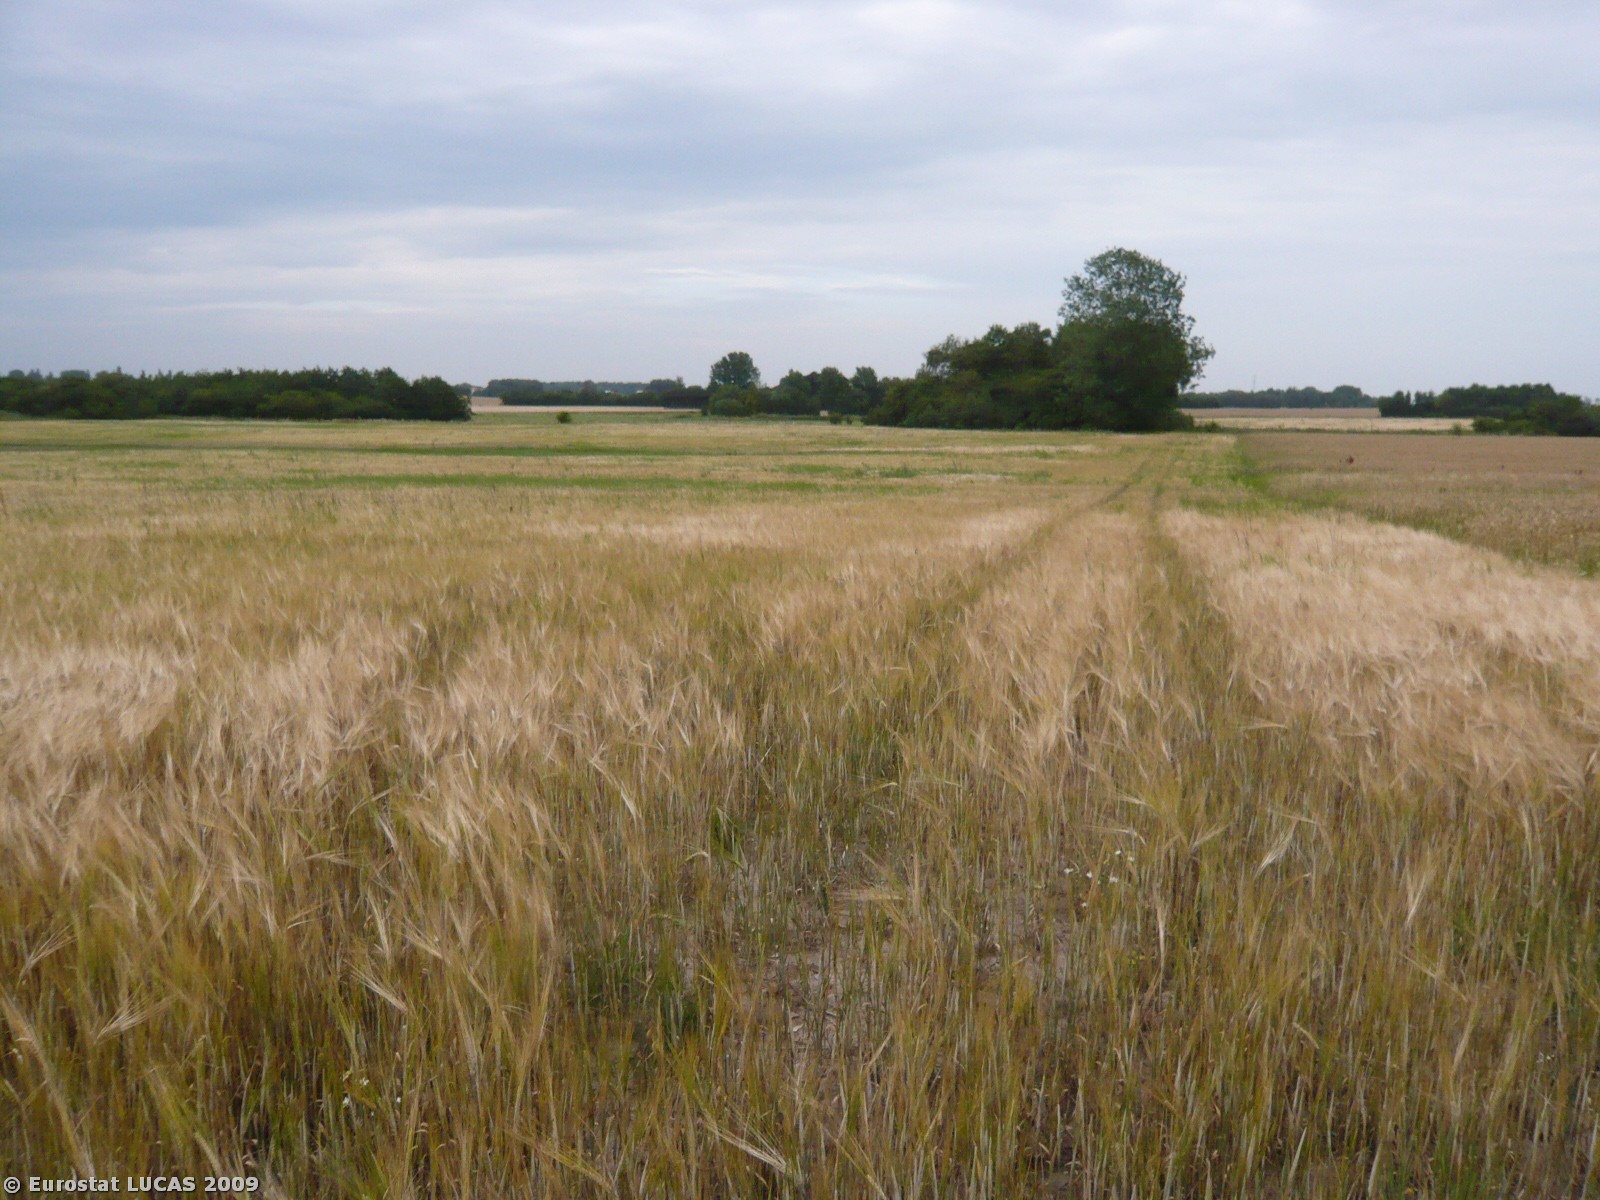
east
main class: Cropland
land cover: Barley
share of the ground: > 75 %
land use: Agriculture (excluding fallow land and kitchen gardens)
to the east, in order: Barley; Fences; Grassland without tree/shrub cover; Fences; Grassland without tree/shrub cover; Fences; Grassland without tree/shrub cover; Inland water bodies; Inland marshes; Broadleaved woodland; Grassland without tree/shrub cover; Fences; Grassland without tree/shrub cover
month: July
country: DK
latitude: 55.8830
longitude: 12.0923
